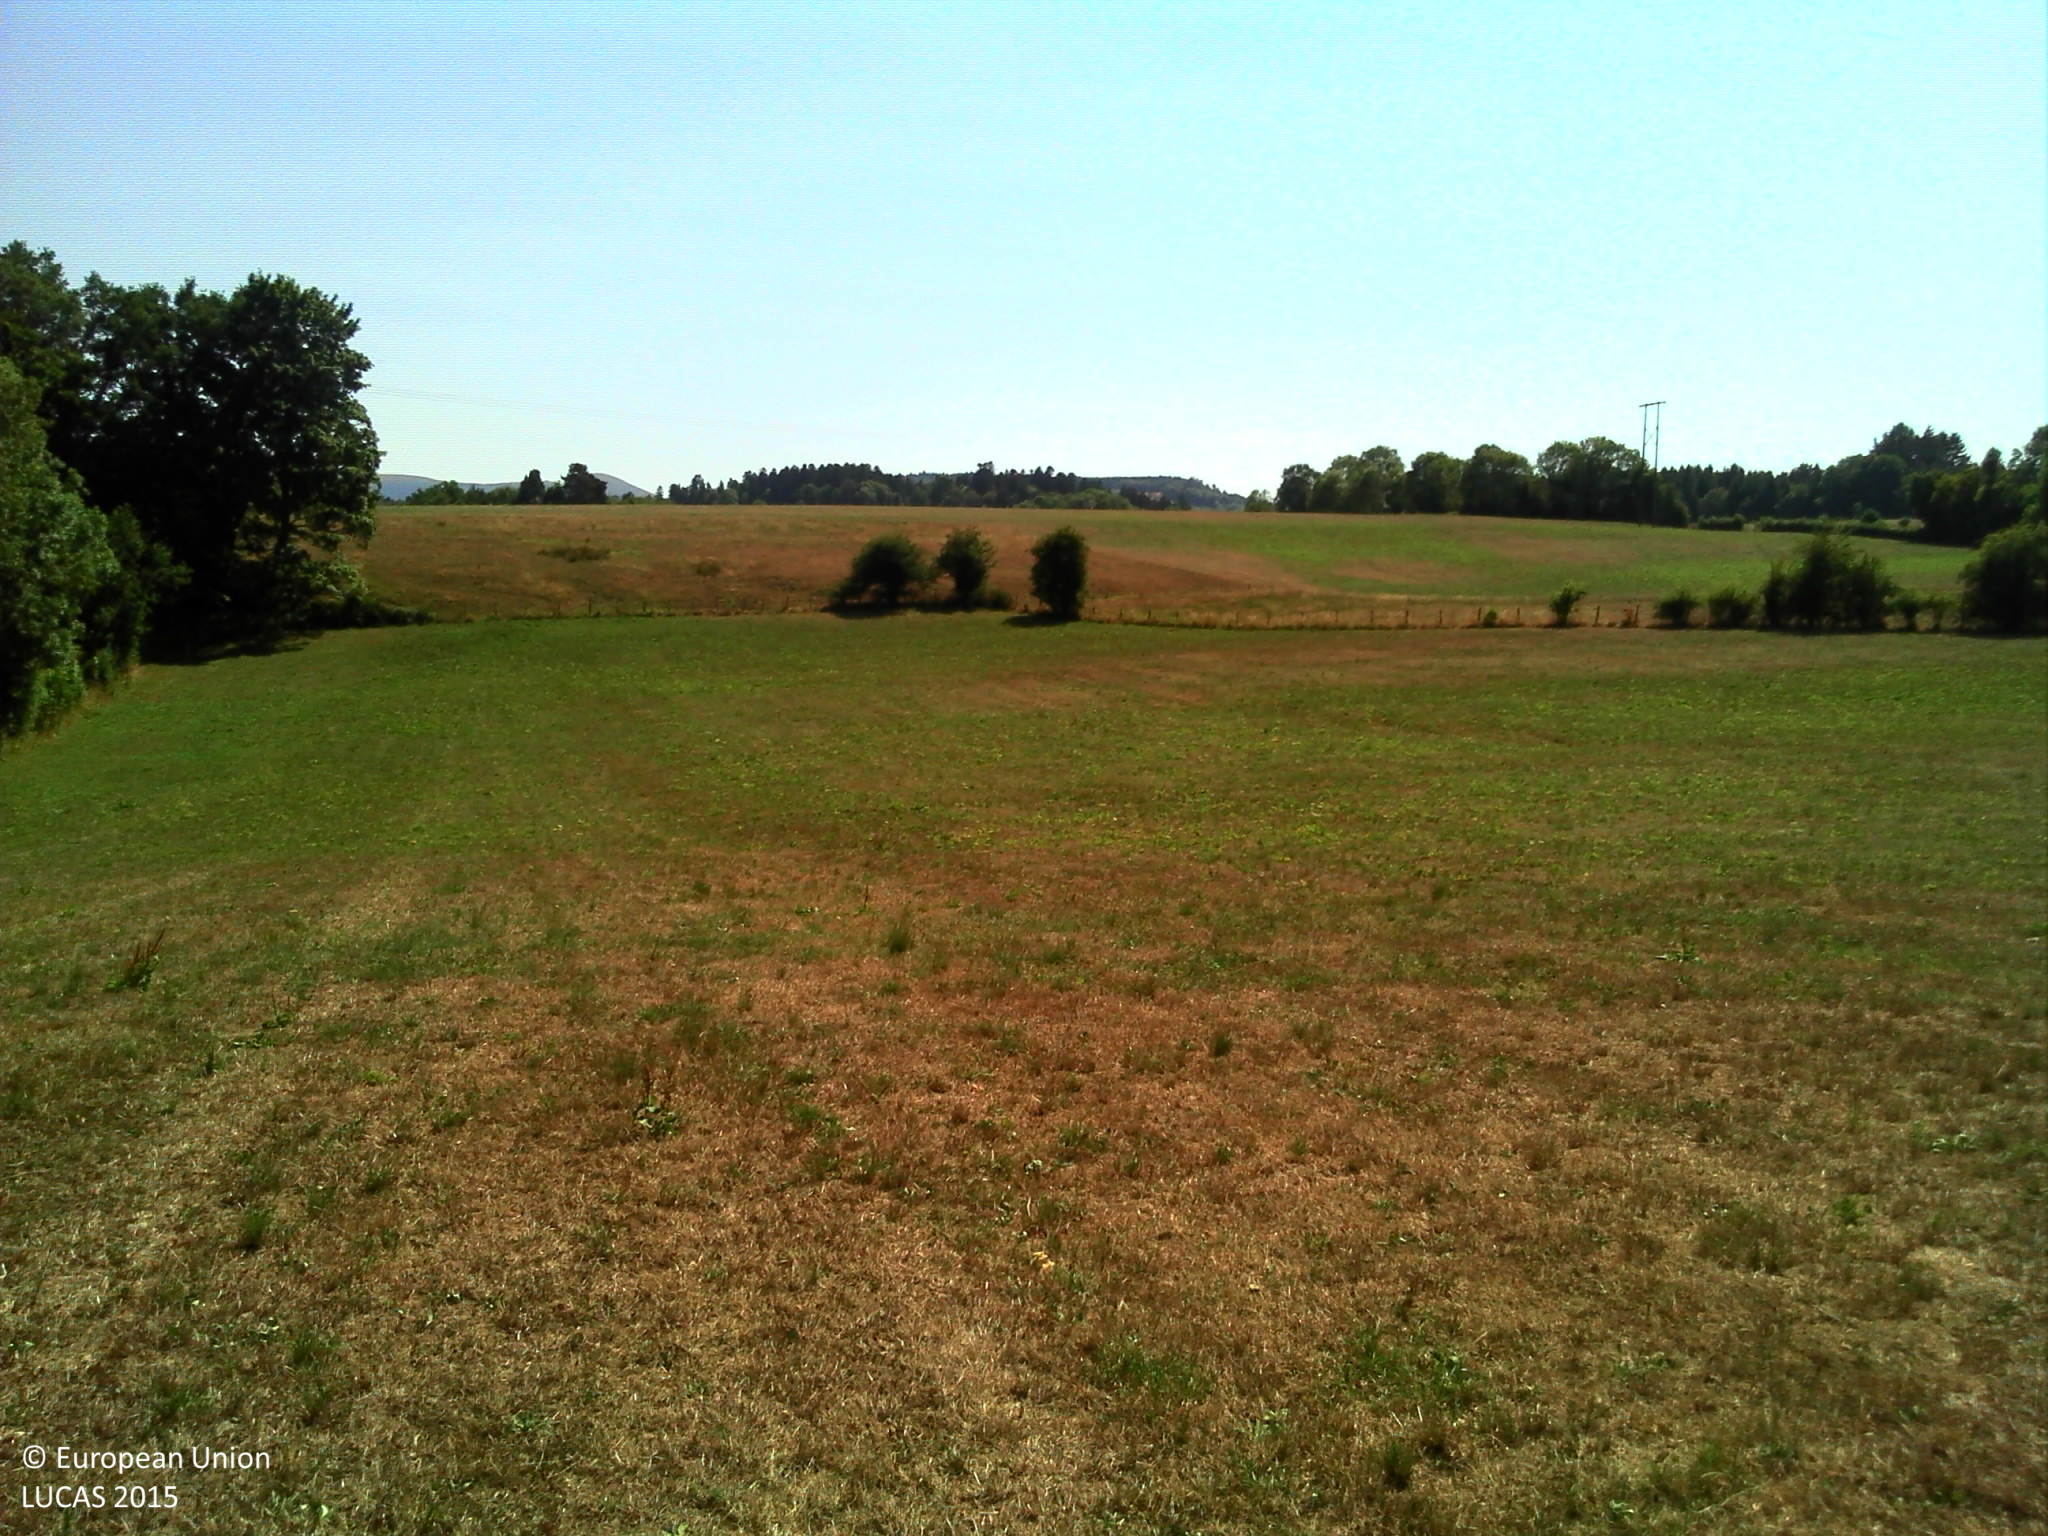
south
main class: Grassland
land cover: Grassland without tree/shrub cover
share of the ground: > 75 %
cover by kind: herbaceous plants 100 %
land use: Agriculture (excluding fallow land and kitchen gardens)
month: August
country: FR
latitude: 45.7136
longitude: 2.8437
